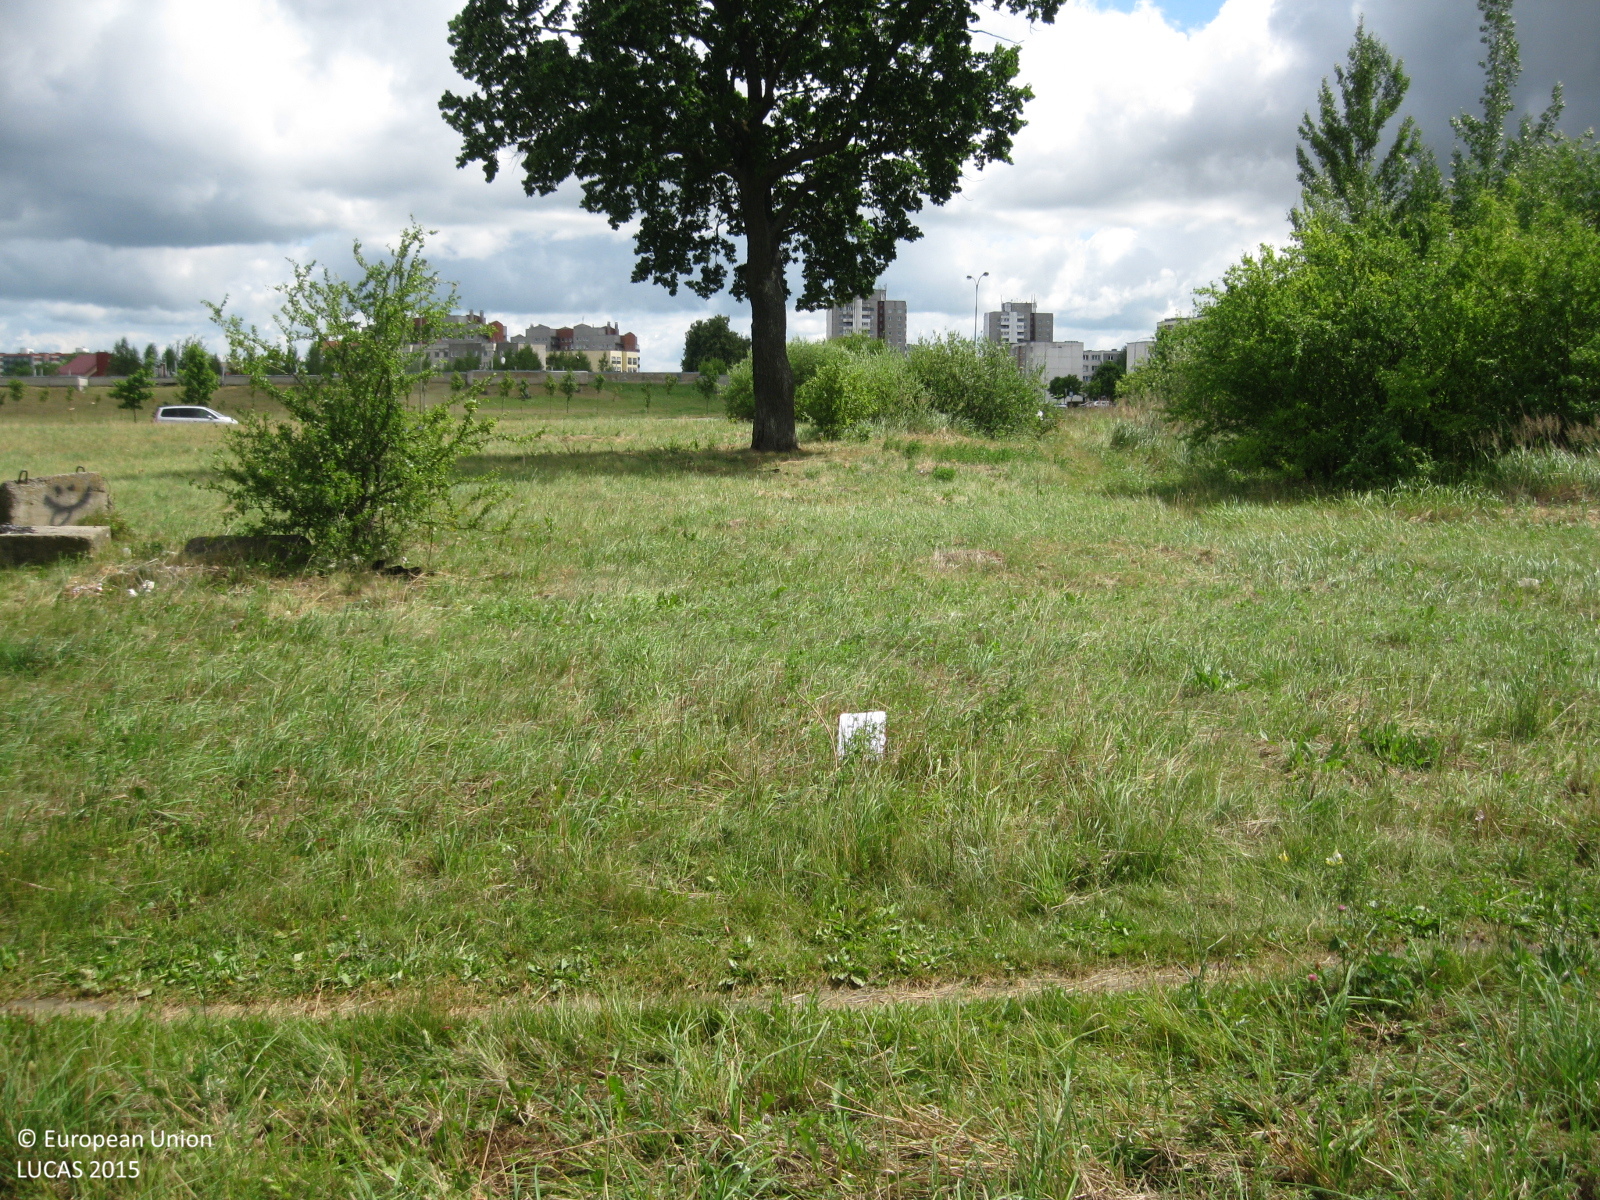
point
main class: Grassland
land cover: Grassland with sparse tree/shrub cover
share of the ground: > 75 %
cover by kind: herbaceous plants 90 %, broadleaved forest trees 5 %, shrubs 5 %
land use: Amenities, museums, leisure
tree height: > 5 m
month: July
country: LT
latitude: 55.7270
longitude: 24.3139
